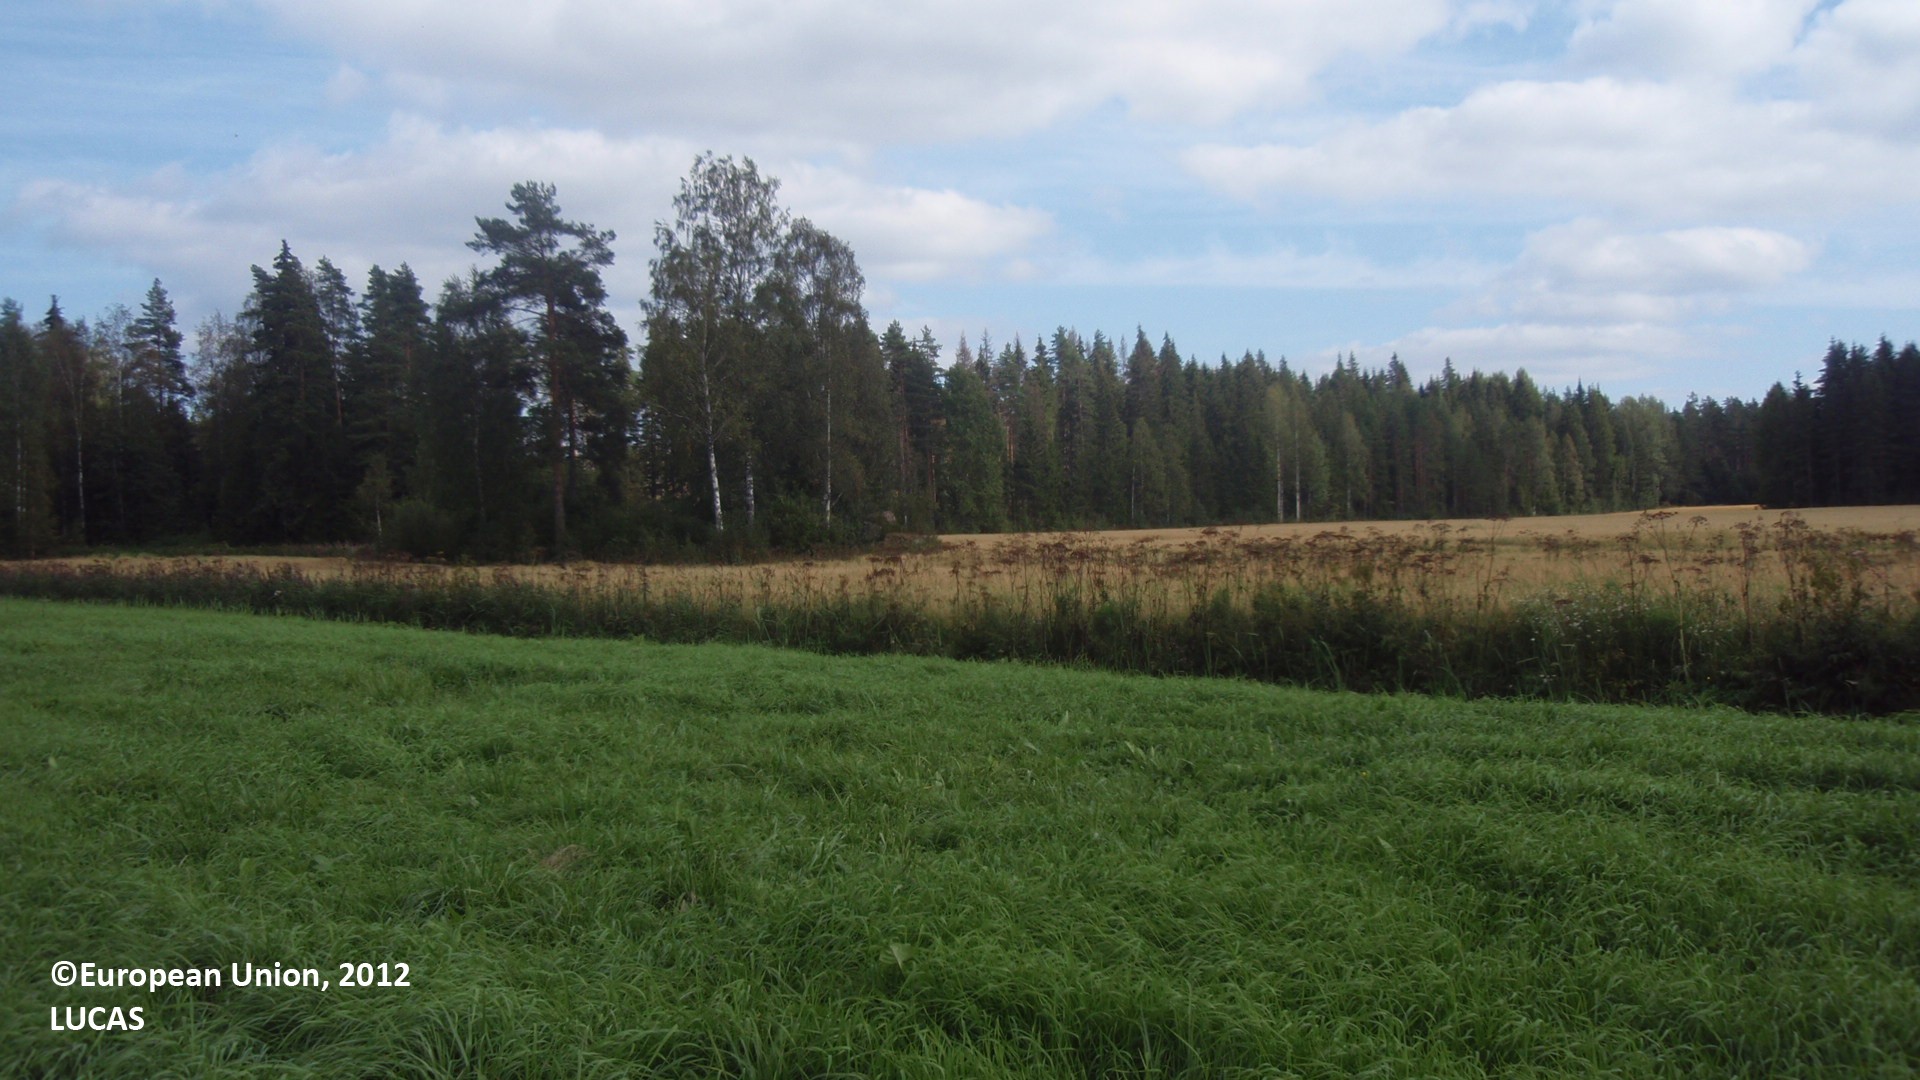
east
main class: Cropland
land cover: Temporary grasslands
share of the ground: > 75 %
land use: Agriculture (excluding fallow land and kitchen gardens)
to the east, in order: Temporary grasslands; Ditches and canals; Oats; Ditches and canals; Oats; Broadleaved woodland; Grassland with sparse tree/shrub cover; Tracks; Grass margins; Pine dominated mixed woodland; Ditches and canals; Oats; Ditches and canals; Shrubland with sparse tree cover
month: August
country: FI
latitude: 60.8291
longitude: 27.2245
